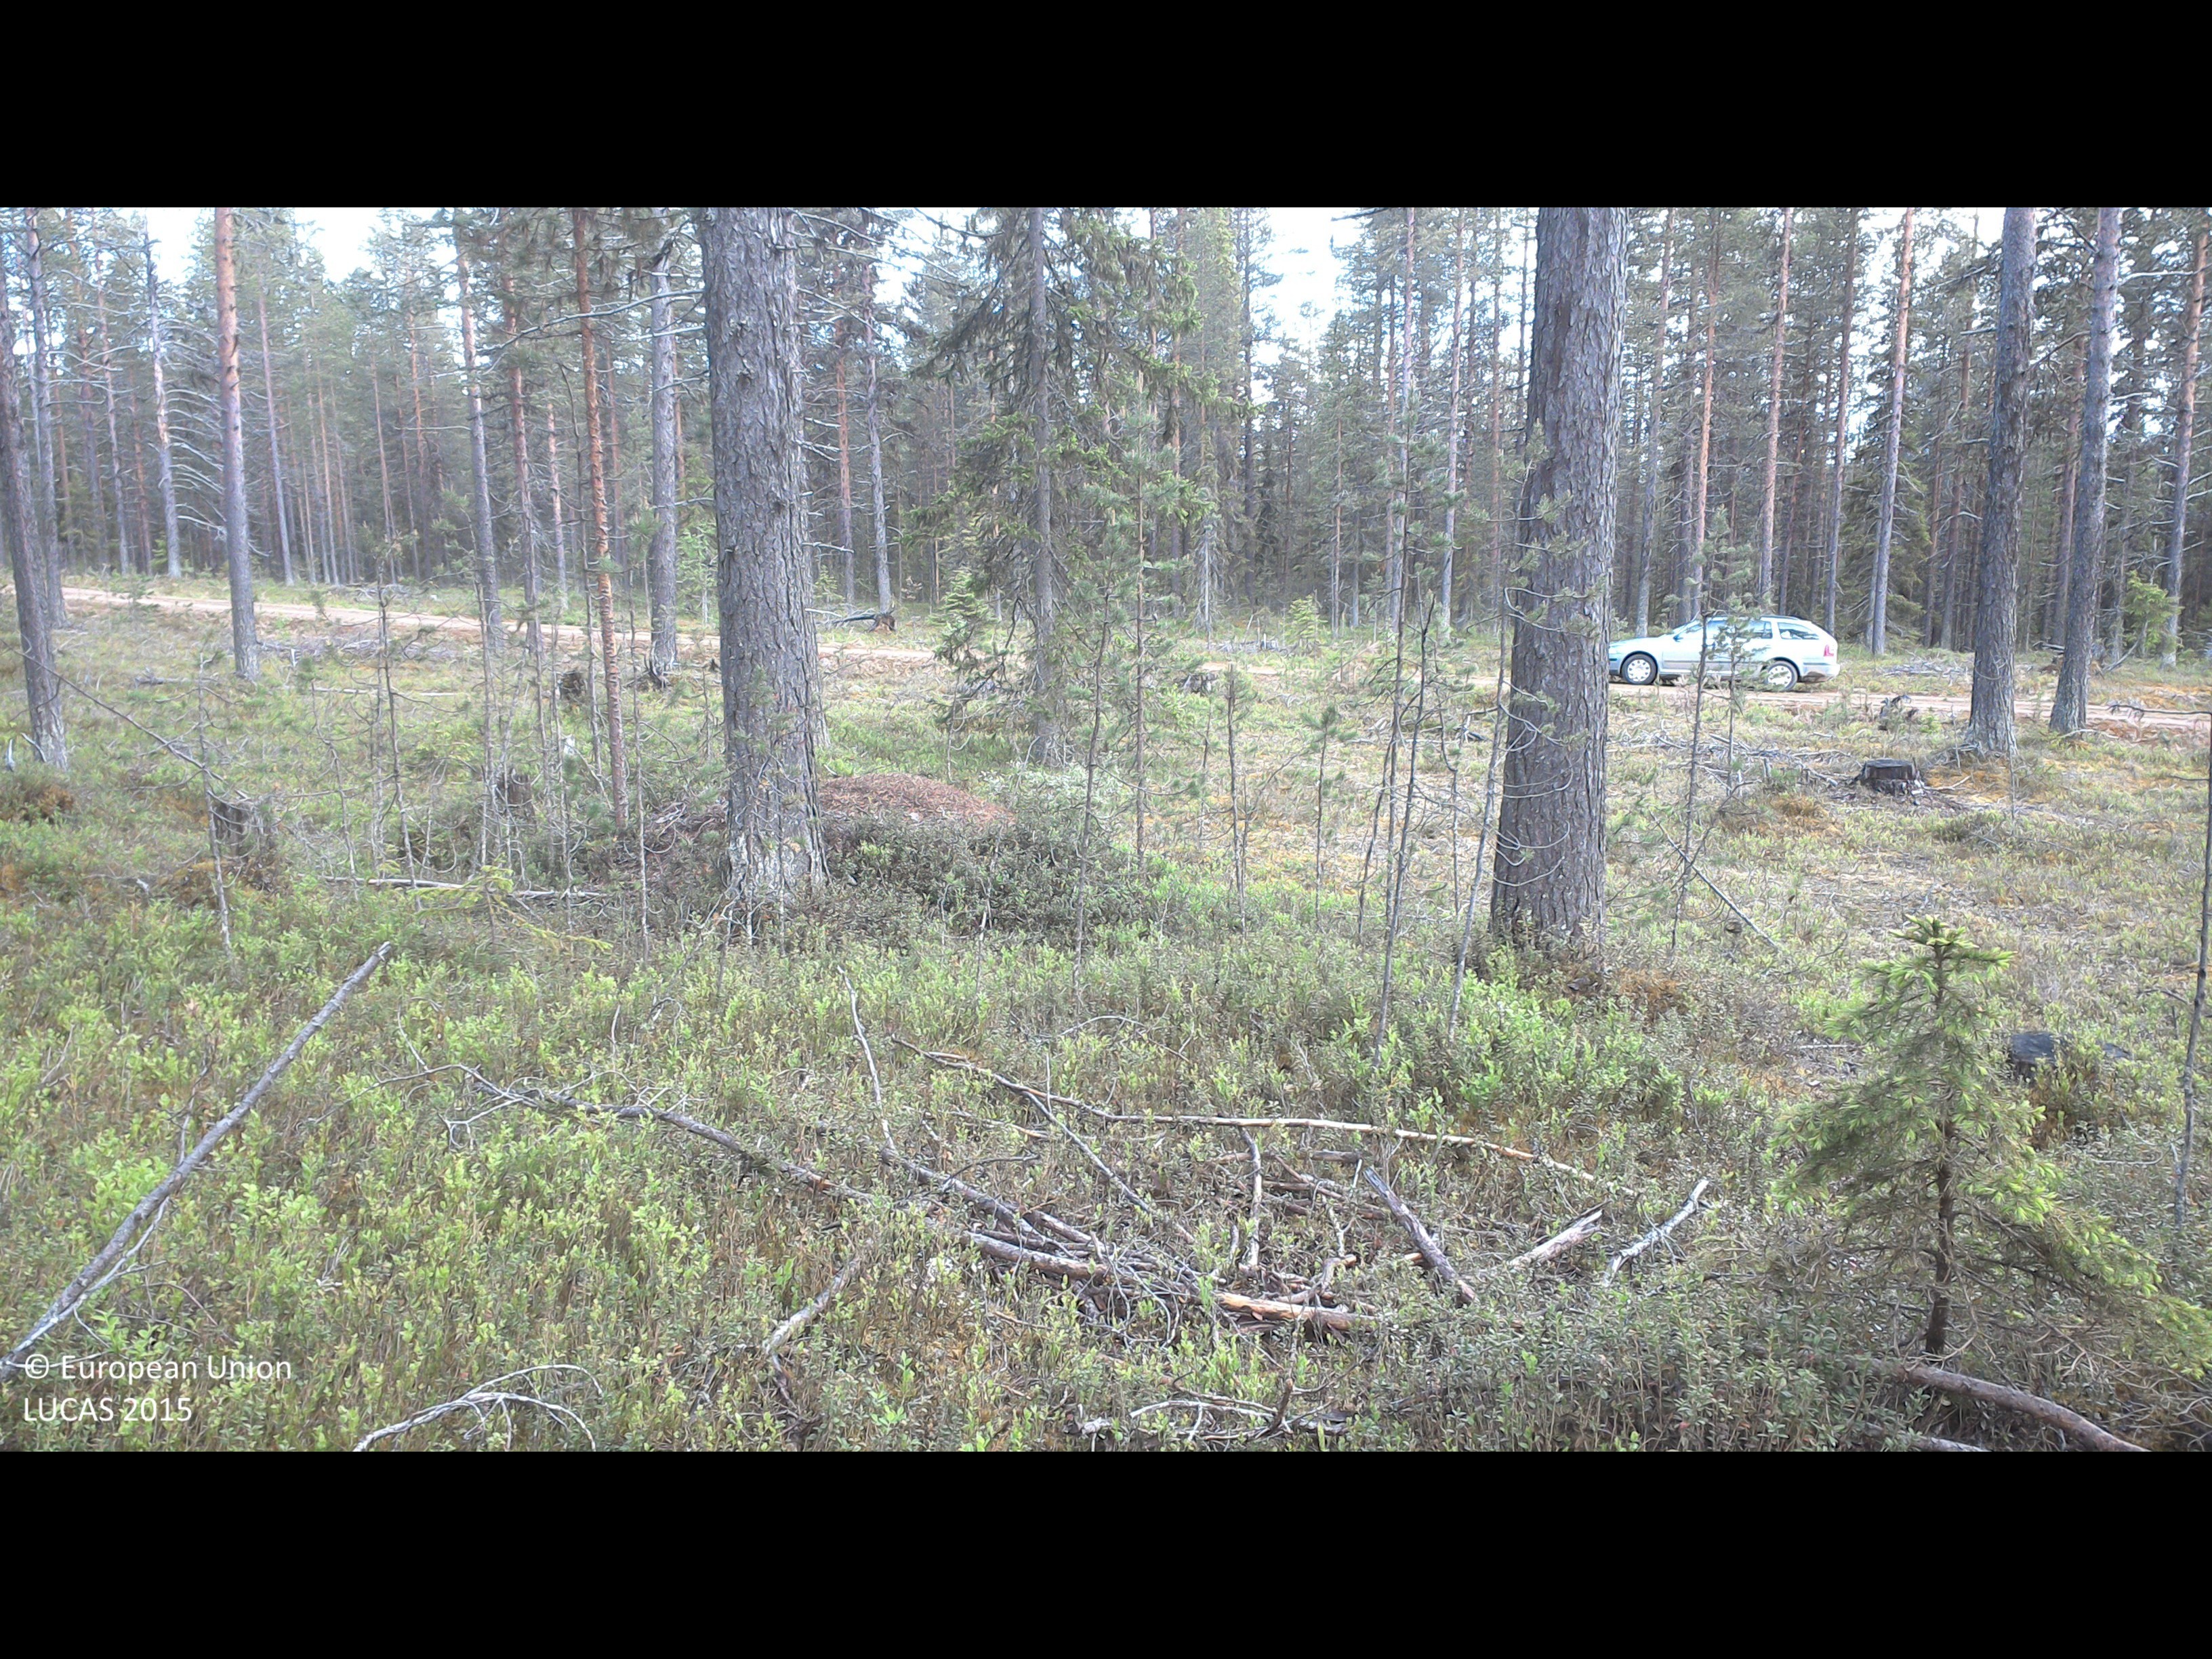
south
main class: Woodland
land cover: Pine dominated coniferous woodland
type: boreal forest
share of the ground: 25 - 50 %
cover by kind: shrubs 70 %, coniferous forest trees 25 %, lichens and mosses 5 %
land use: Forestry
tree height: > 5 m
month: June
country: SE
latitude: 67.0281
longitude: 22.4317
